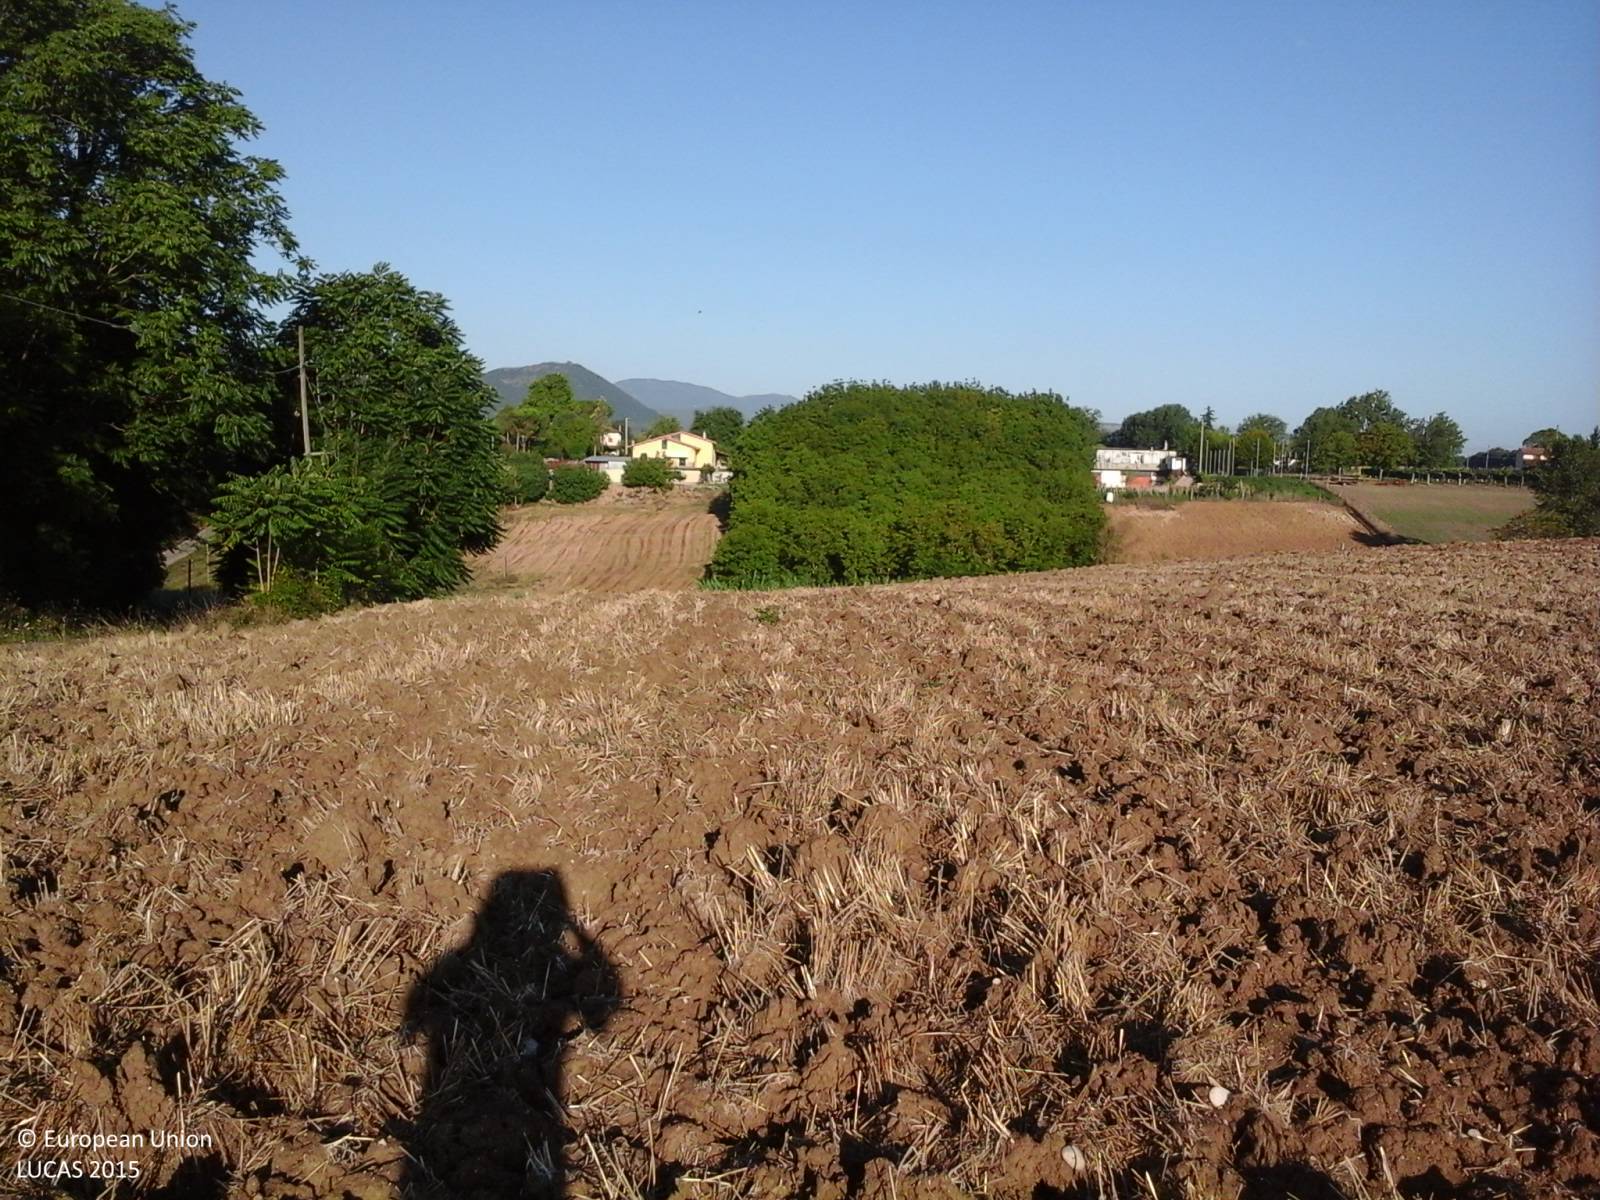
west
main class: Cropland
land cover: Common wheat
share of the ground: < 10 %
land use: Agriculture (excluding fallow land and kitchen gardens)
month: August
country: IT
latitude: 41.4656
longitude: 13.6856
